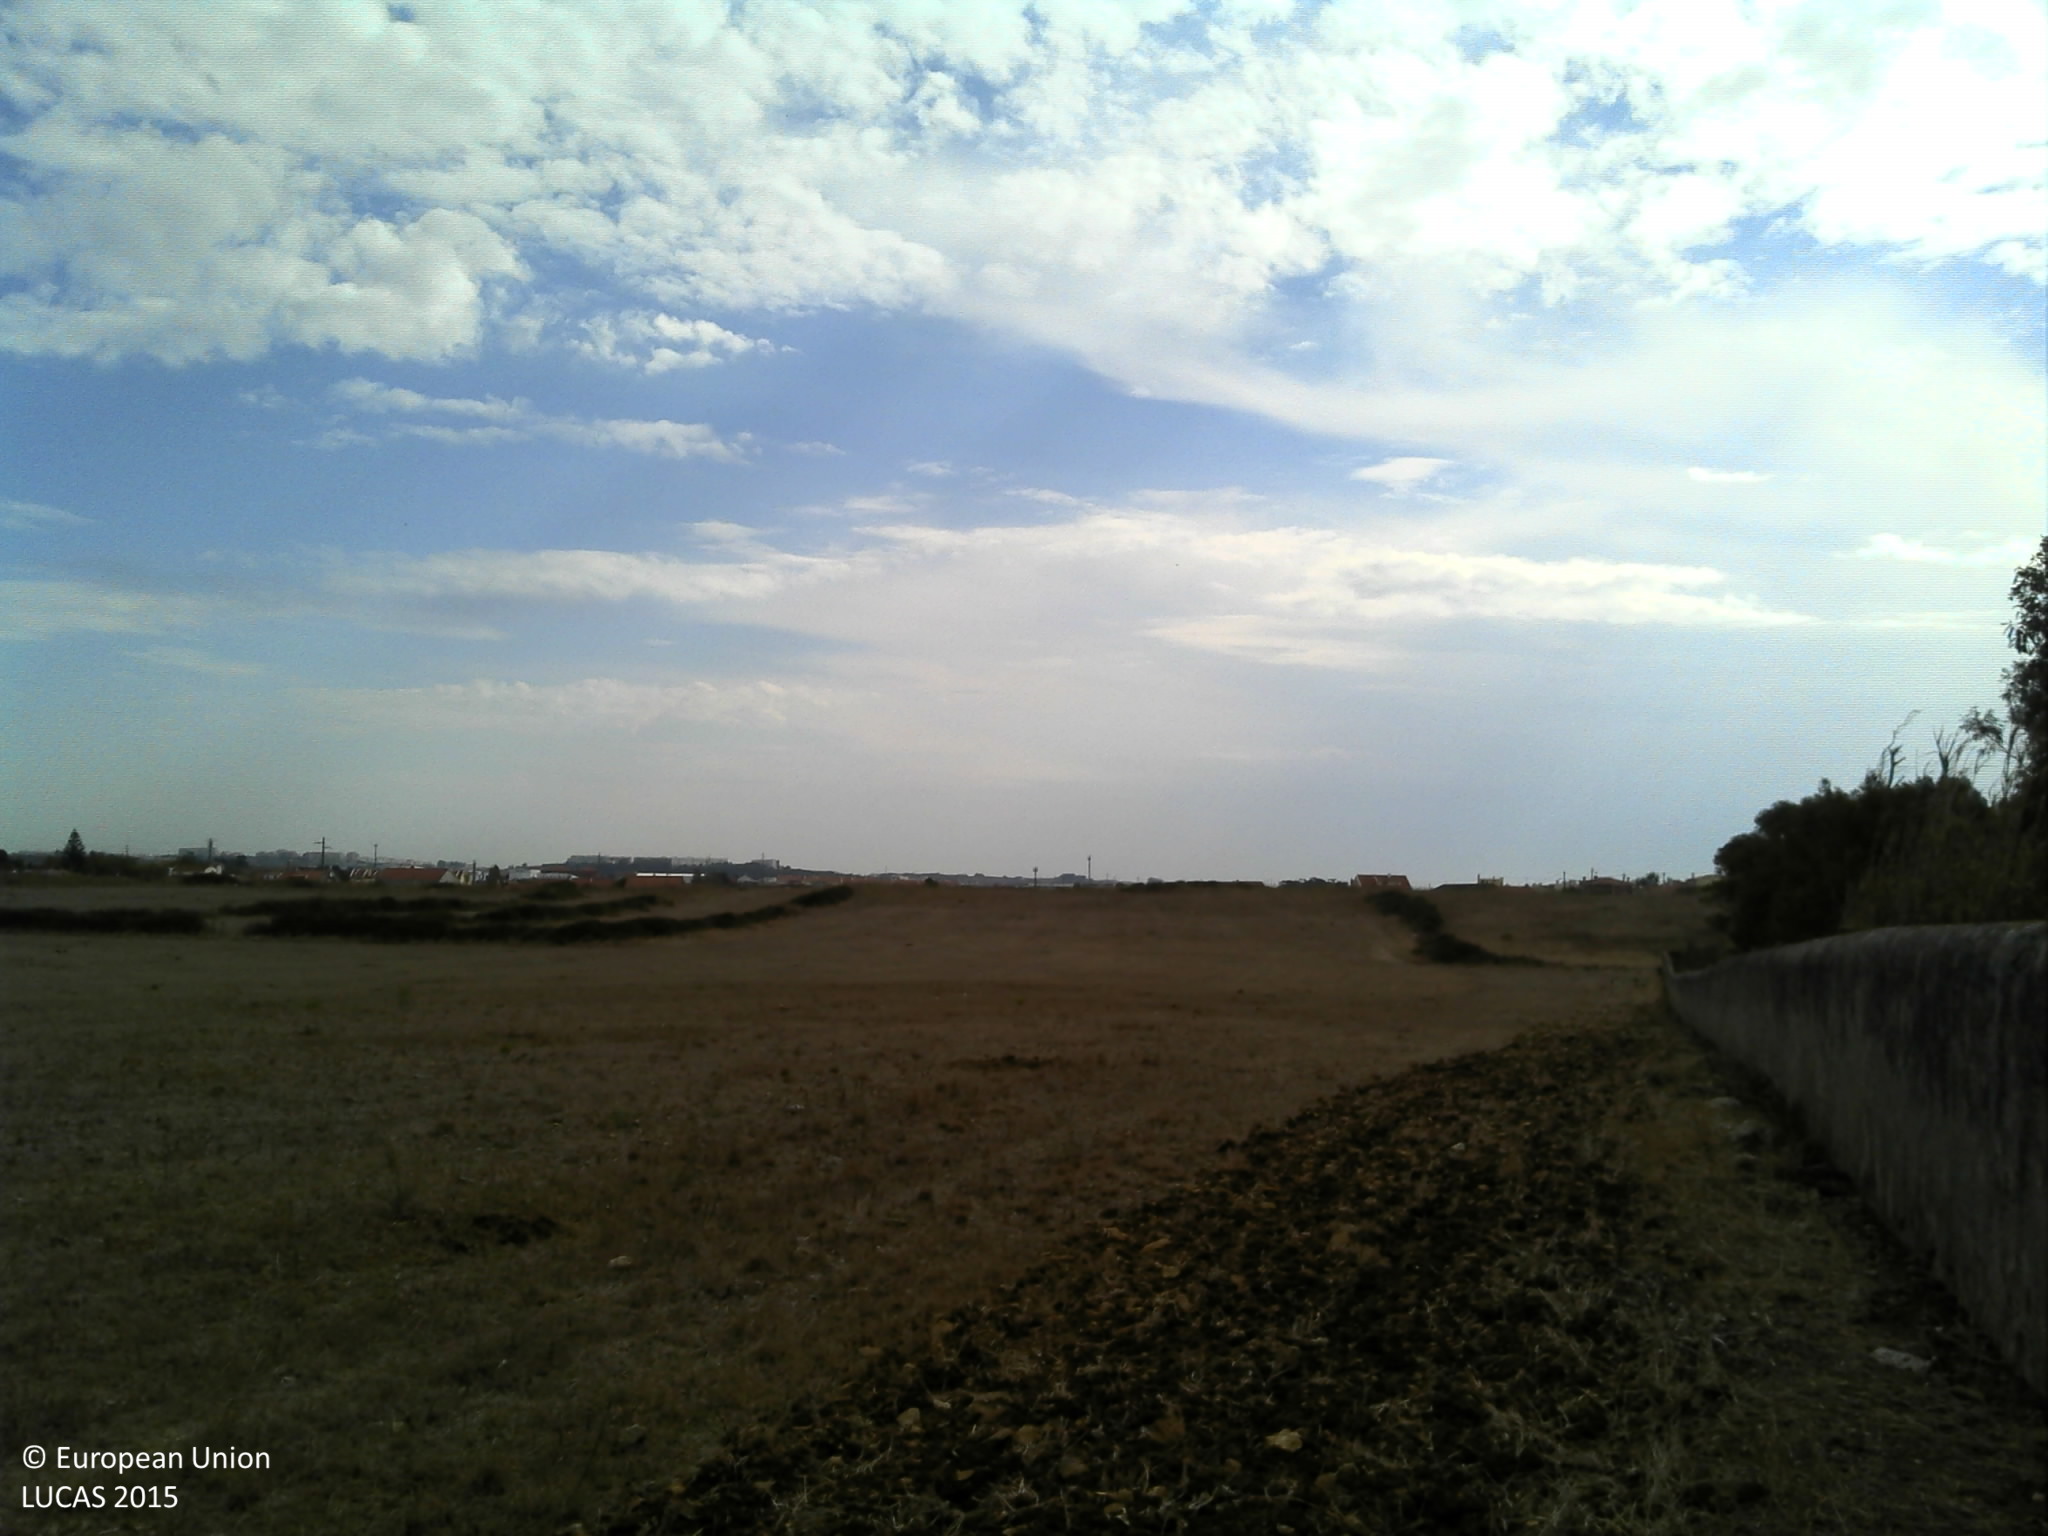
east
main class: Woodland
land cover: Broadleaved woodland
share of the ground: 25 - 50 %
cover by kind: broadleaved forest trees 50 %, unconsolidated bare surface 30 %, shrubs 10 %, herbaceous plants 10 %
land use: Community services
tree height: > 5 m
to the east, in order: Broadleaved woodland; Artificial constructions; Grassland without tree/shrub cover
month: September
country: PT
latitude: 38.7283
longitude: -9.3487
